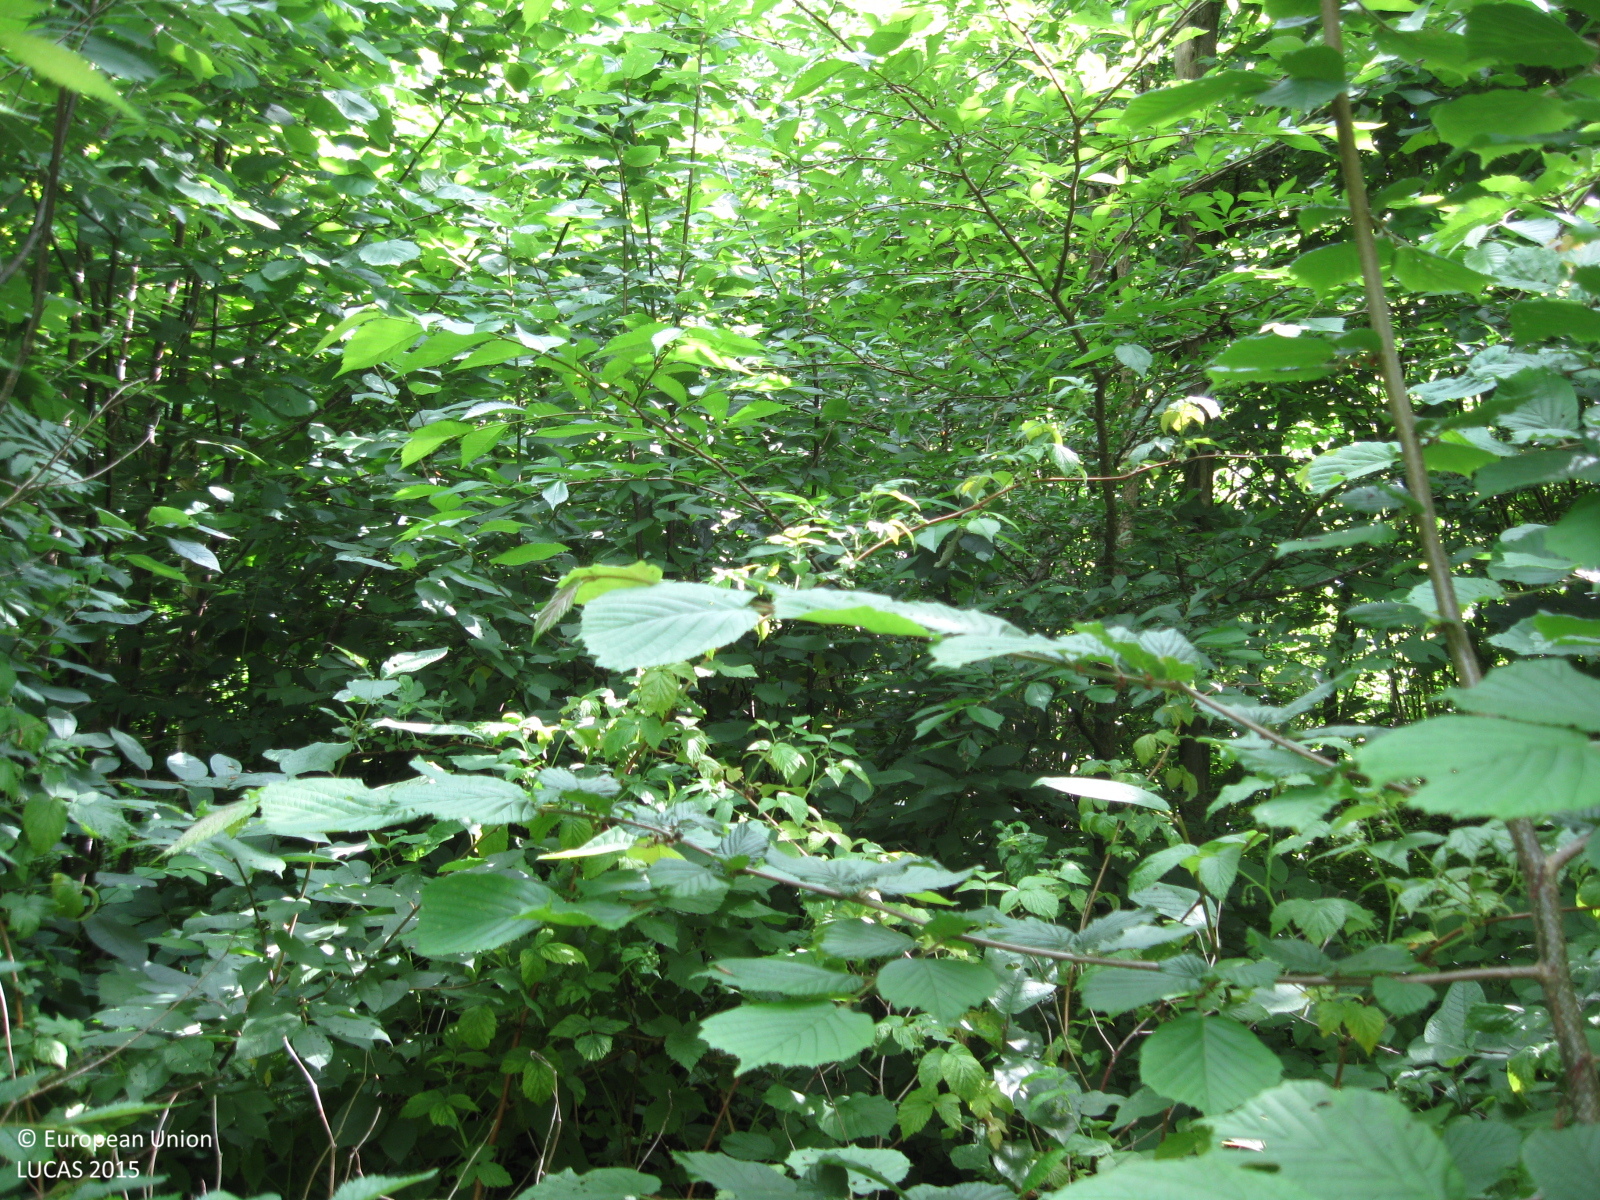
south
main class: Woodland
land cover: Broadleaved woodland
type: non-riverine alder, birch or aspen forest
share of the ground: 50 - 75 %
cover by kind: broadleaved forest trees 70 %, shrubs 15 %, herbaceous plants 15 %
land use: Forestry
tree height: > 5 m
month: June
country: LT
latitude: 55.3788
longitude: 23.8324
